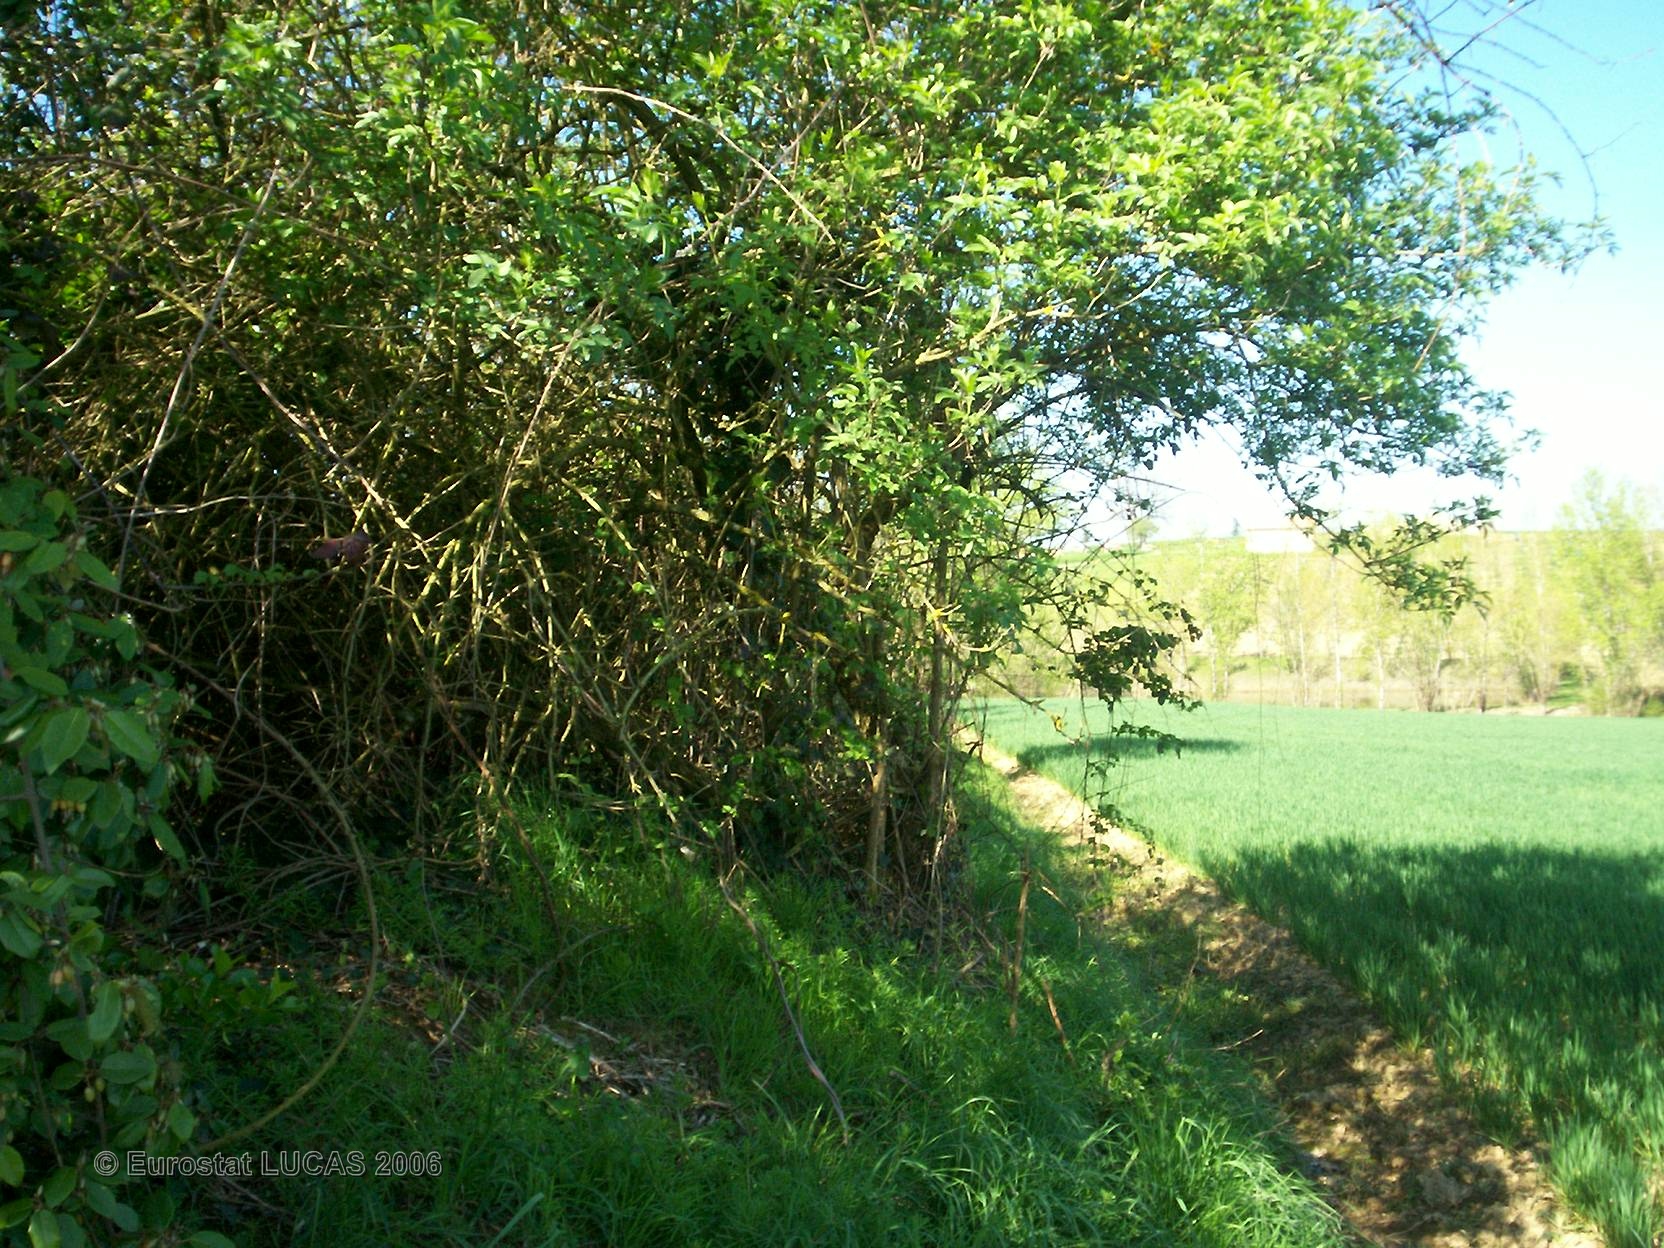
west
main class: Cropland
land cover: Common wheat
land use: Agriculture (excluding fallow land and kitchen gardens)
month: April
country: FR
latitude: 44.0856
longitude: 0.7921
